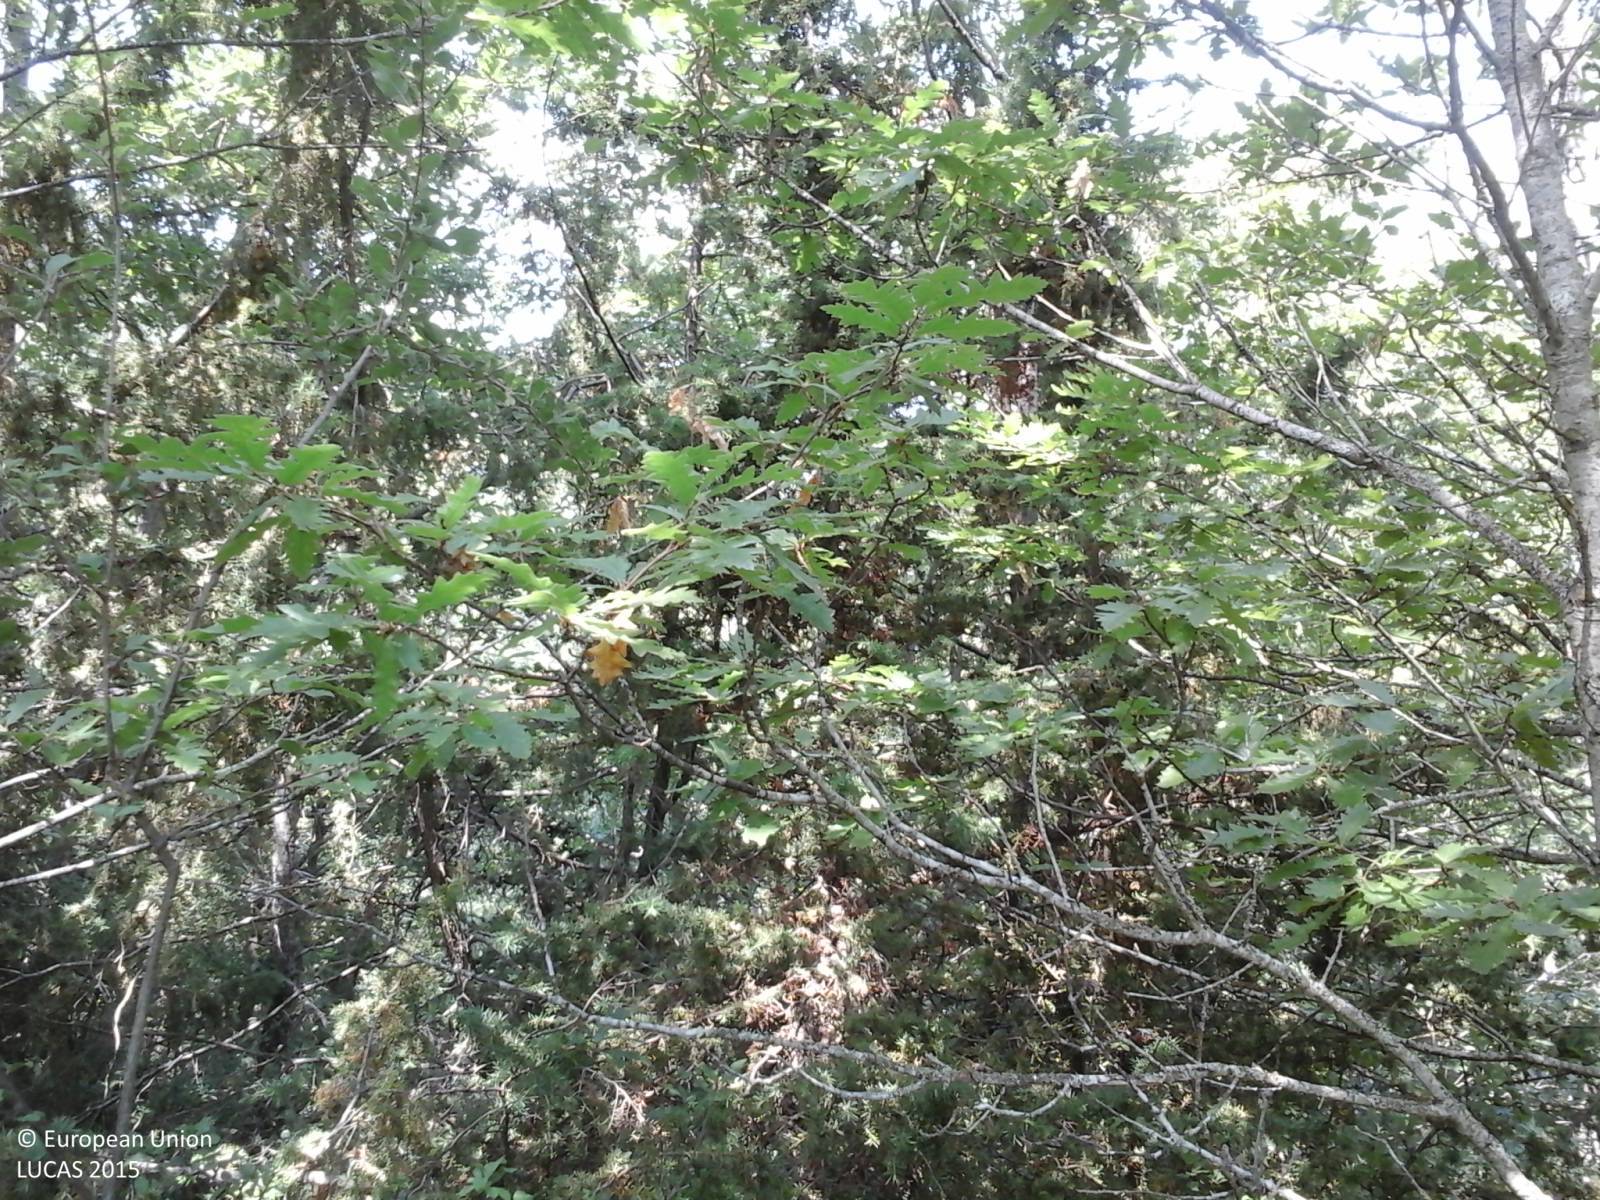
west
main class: Woodland
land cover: Broadleaved woodland
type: thermophilous deciduous forest
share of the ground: > 75 %
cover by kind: broadleaved forest trees 85 %, shrubs 10 %, coniferous forest trees 5 %
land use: Semi-natural and natural areas not in use
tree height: > 5 m
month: July
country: IT
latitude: 42.4922
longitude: 13.2869
